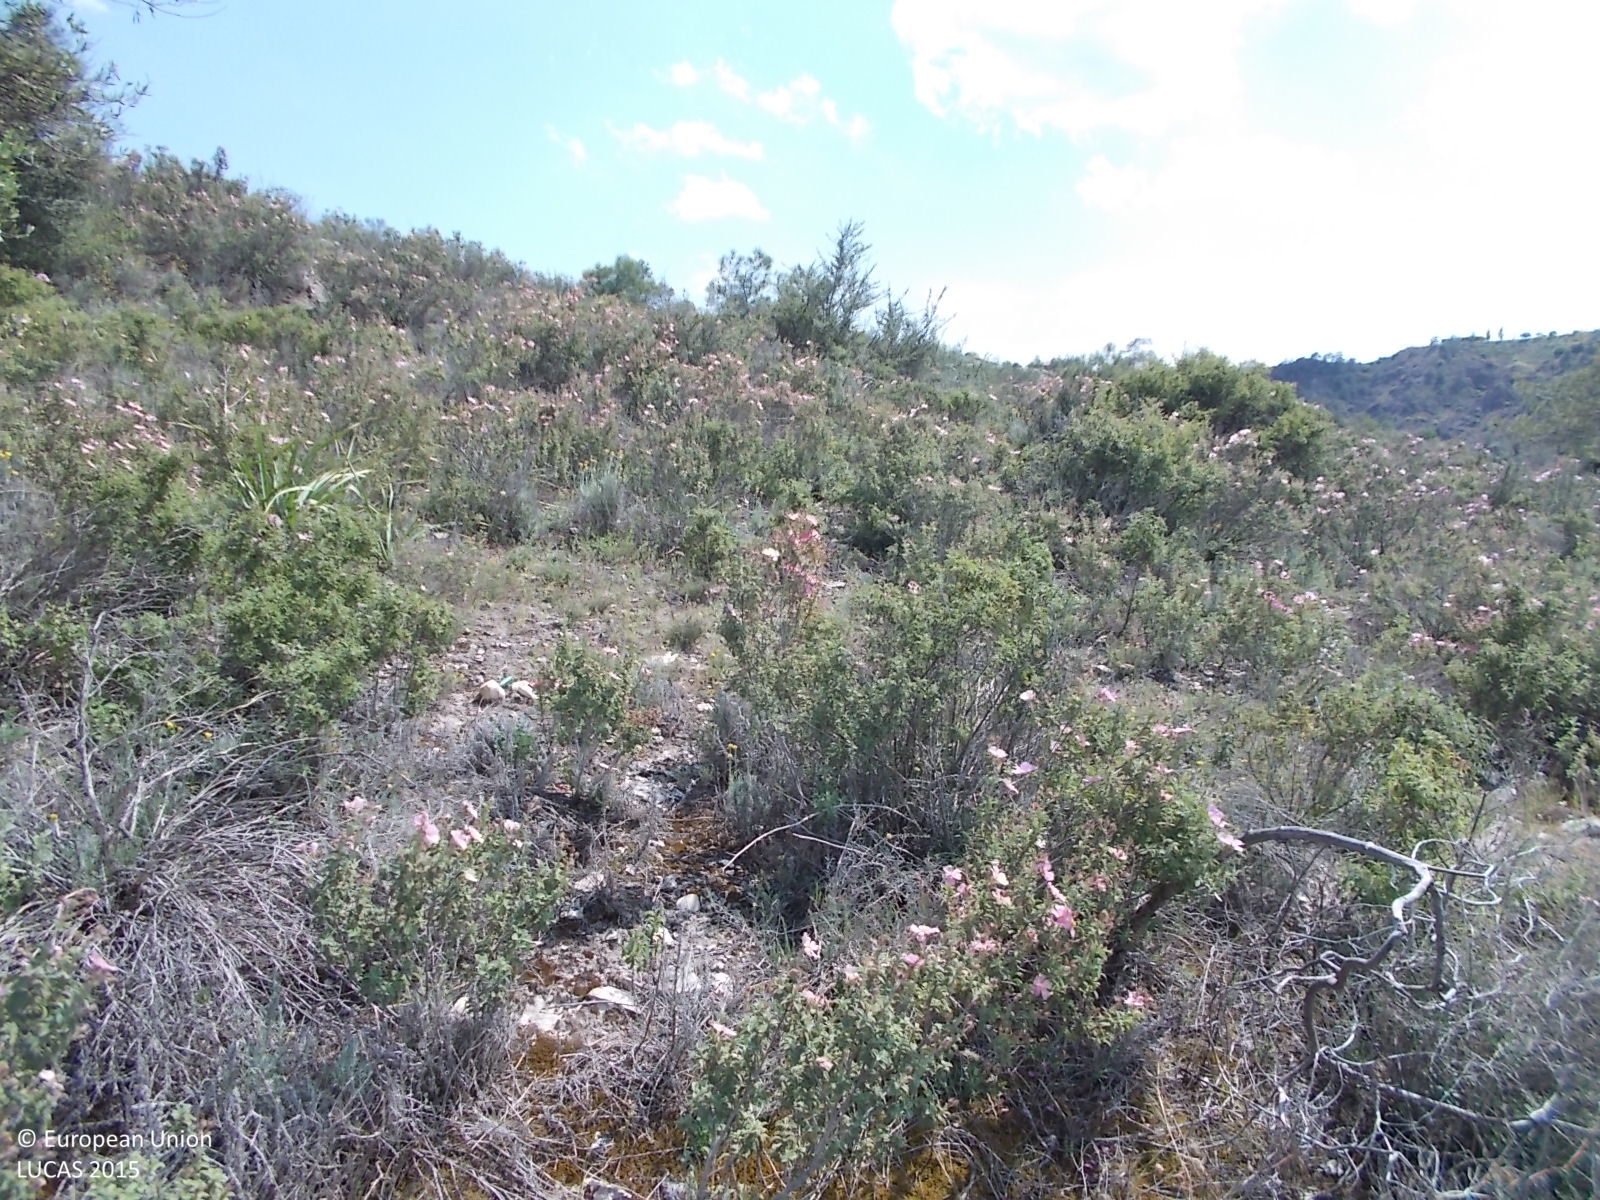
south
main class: Woodland
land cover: Pine dominated coniferous woodland
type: coniferous forest of the mediterranean region
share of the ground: > 75 %
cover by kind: shrubs 70 %, coniferous forest trees 25 %, broadleaved forest trees 5 %
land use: Forestry
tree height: < 5 m
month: April
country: CY
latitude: 34.9389
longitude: 33.4559
